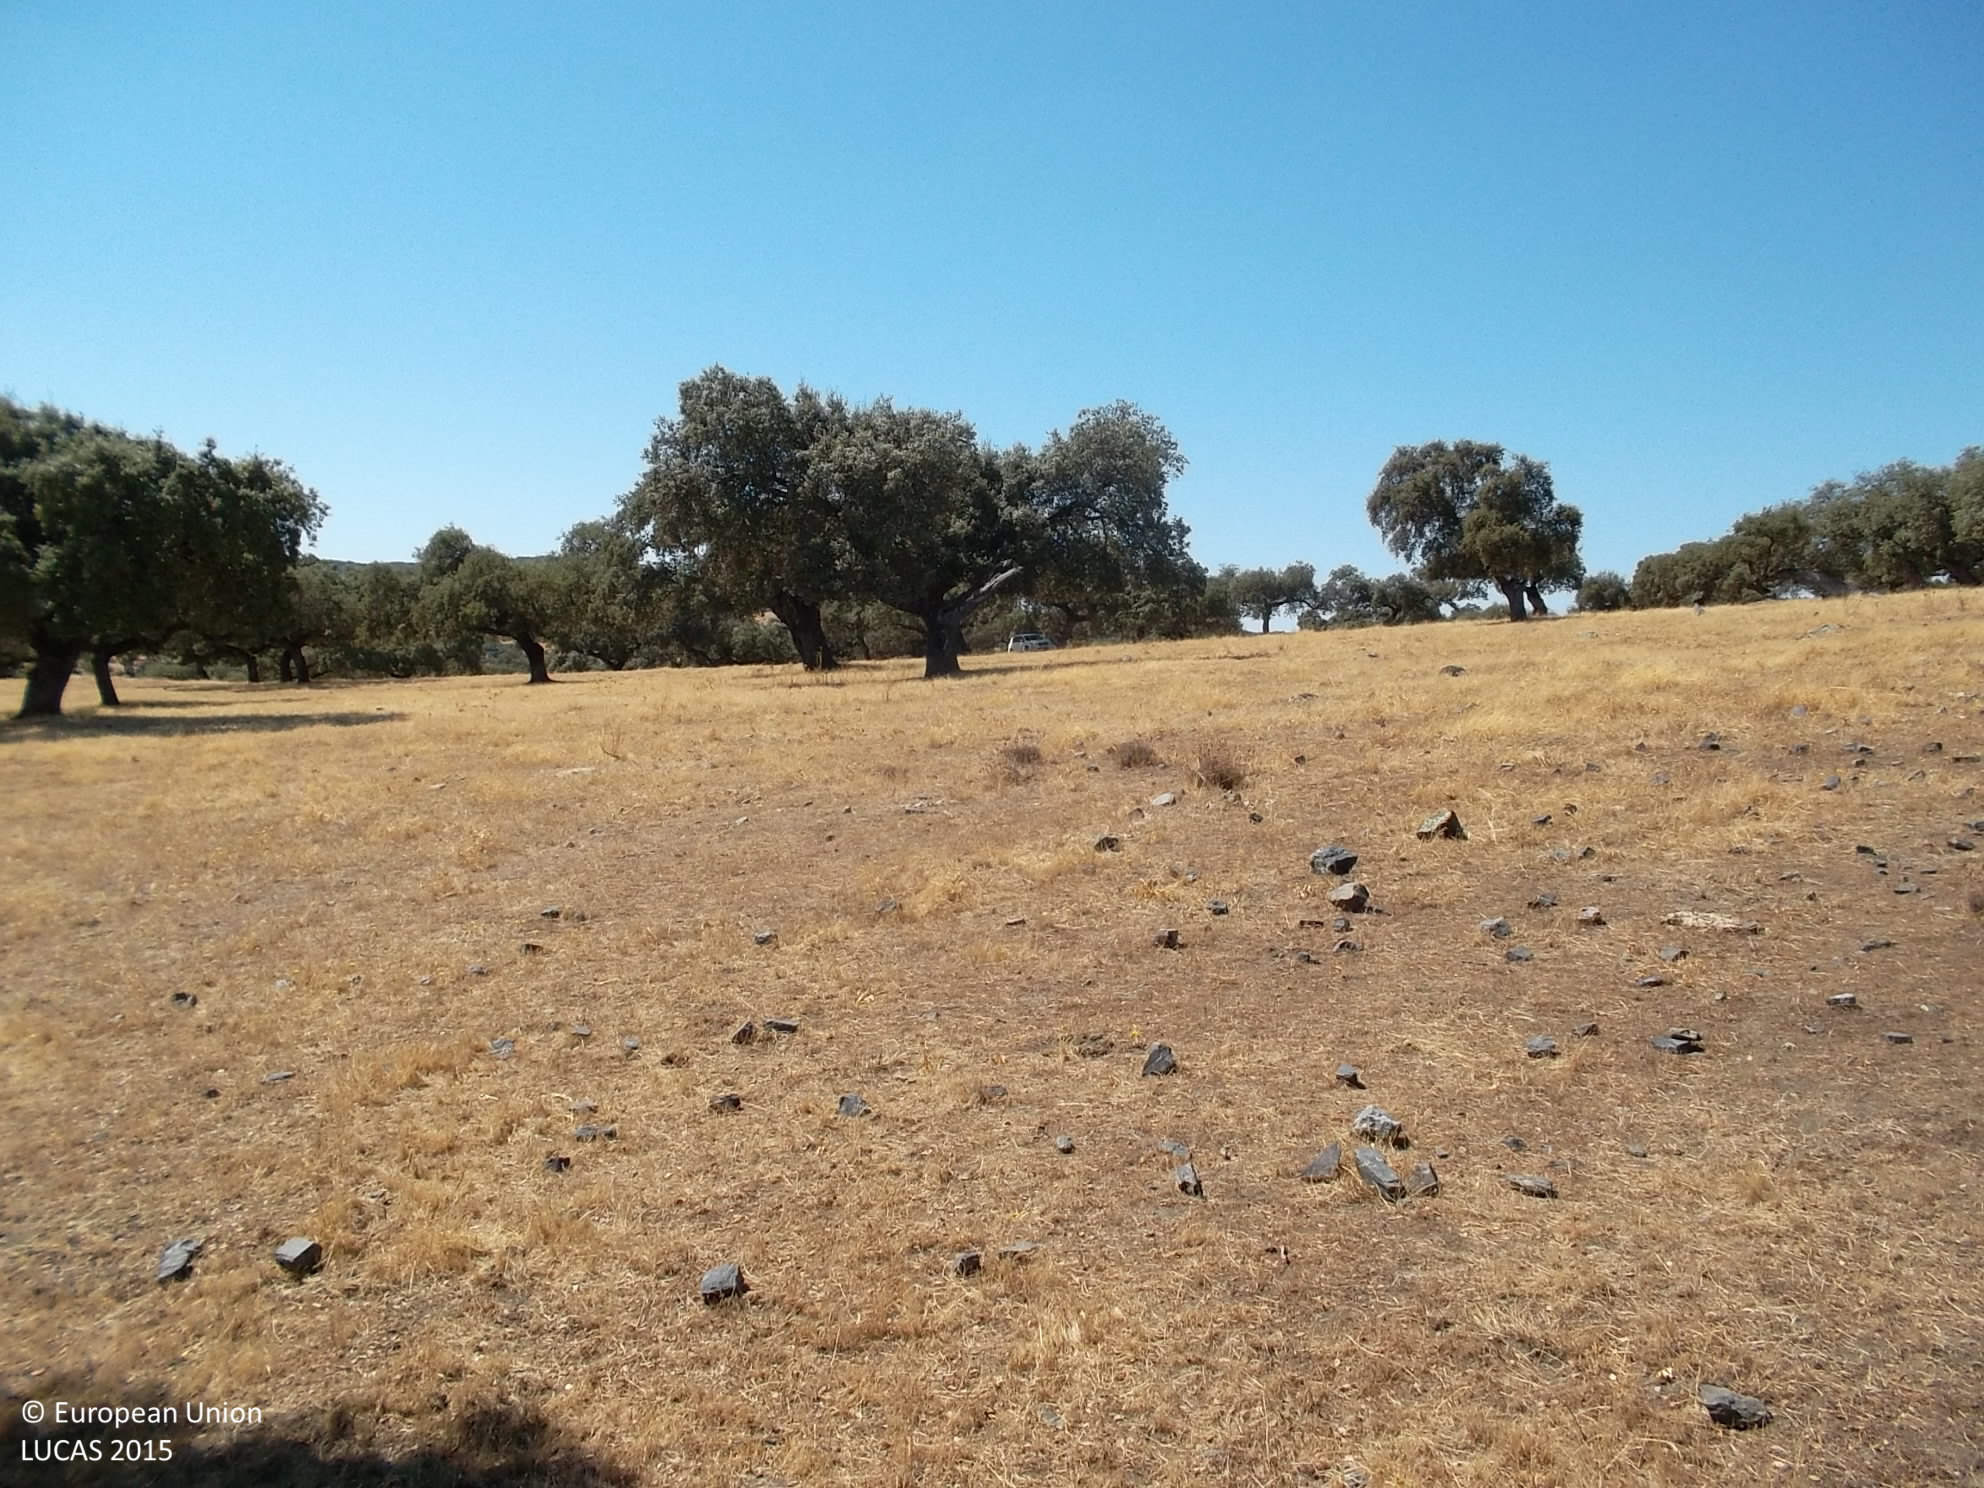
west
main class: Woodland
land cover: Broadleaved woodland
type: broadleaved evergreen forest
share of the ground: 10 - 25 %
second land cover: Grassland without tree/shrub cover
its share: > 75 %
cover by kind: herbaceous plants 85 %, broadleaved forest trees 15 %
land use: Forestry
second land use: Agriculture (excluding fallow land and kitchen gardens)
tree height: > 5 m
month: August
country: ES
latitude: 38.4330
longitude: -6.7247
